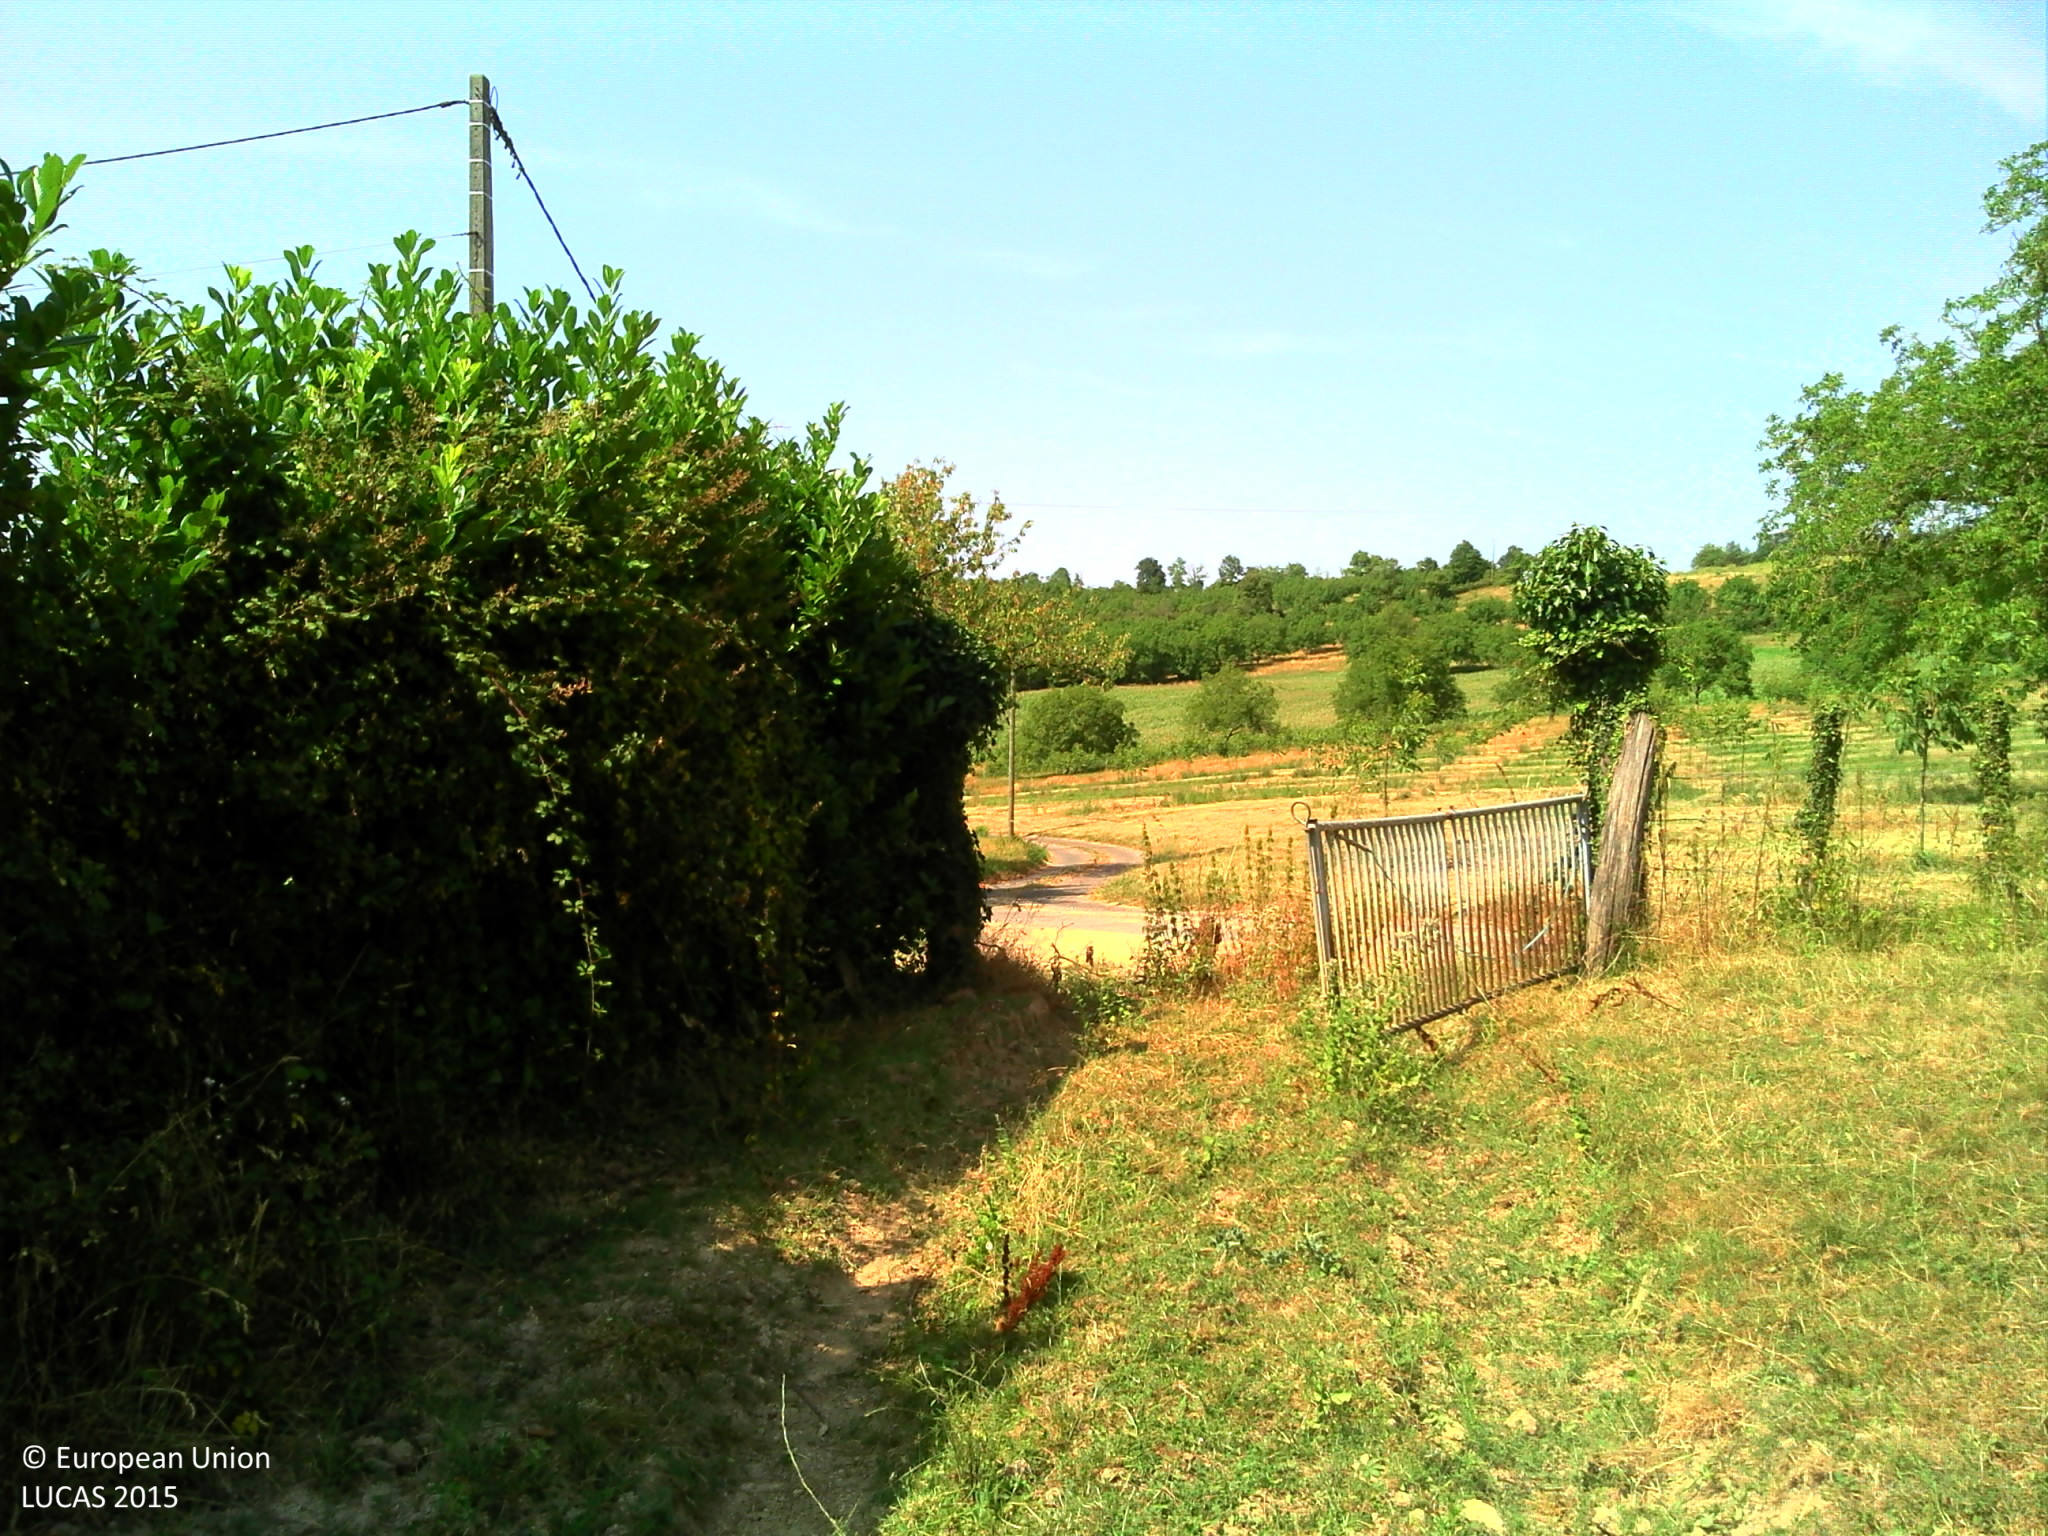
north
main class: Grassland
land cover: Grassland without tree/shrub cover
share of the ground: > 75 %
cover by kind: herbaceous plants 100 %
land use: Agriculture (excluding fallow land and kitchen gardens)
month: July
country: FR
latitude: 45.2242
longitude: 1.1671
